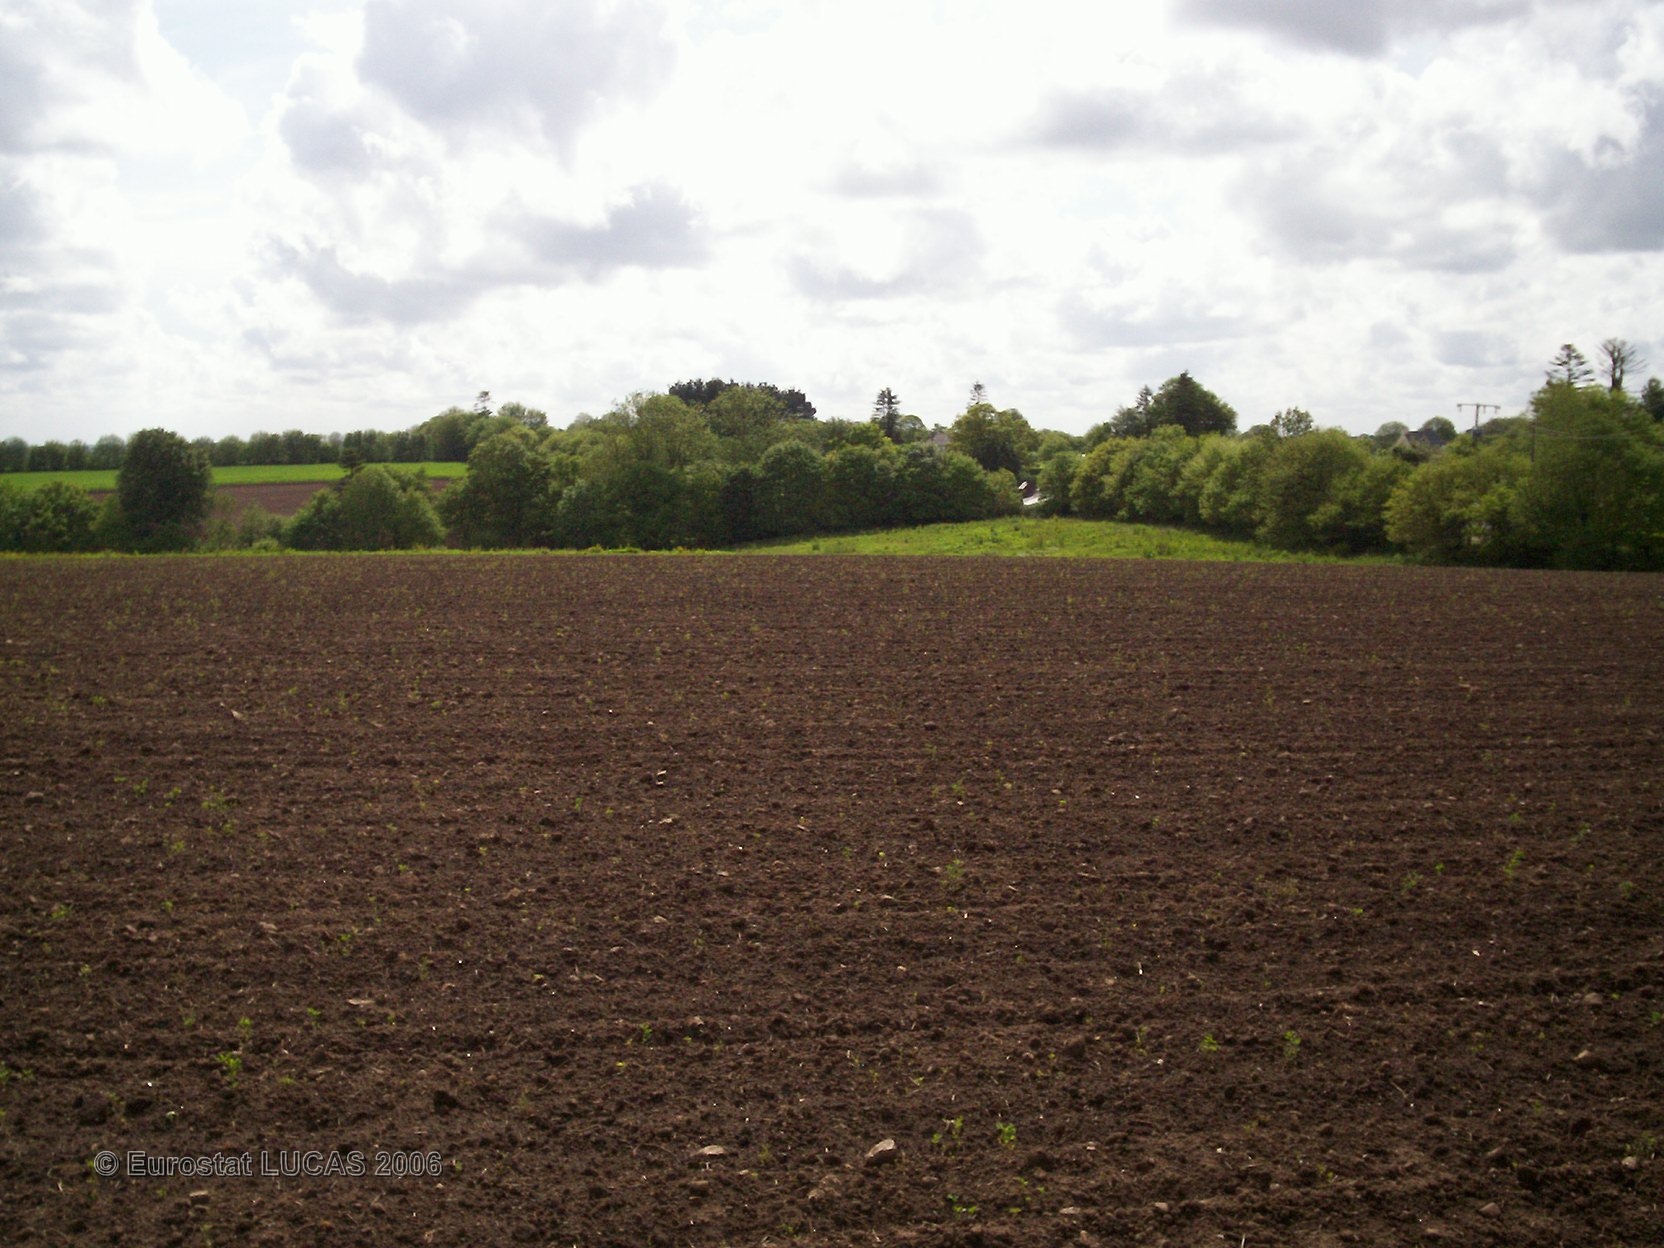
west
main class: Cropland
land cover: Other cereals
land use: Agriculture (excluding fallow land and kitchen gardens)
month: June
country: FR
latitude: 48.0829
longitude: -3.9254
